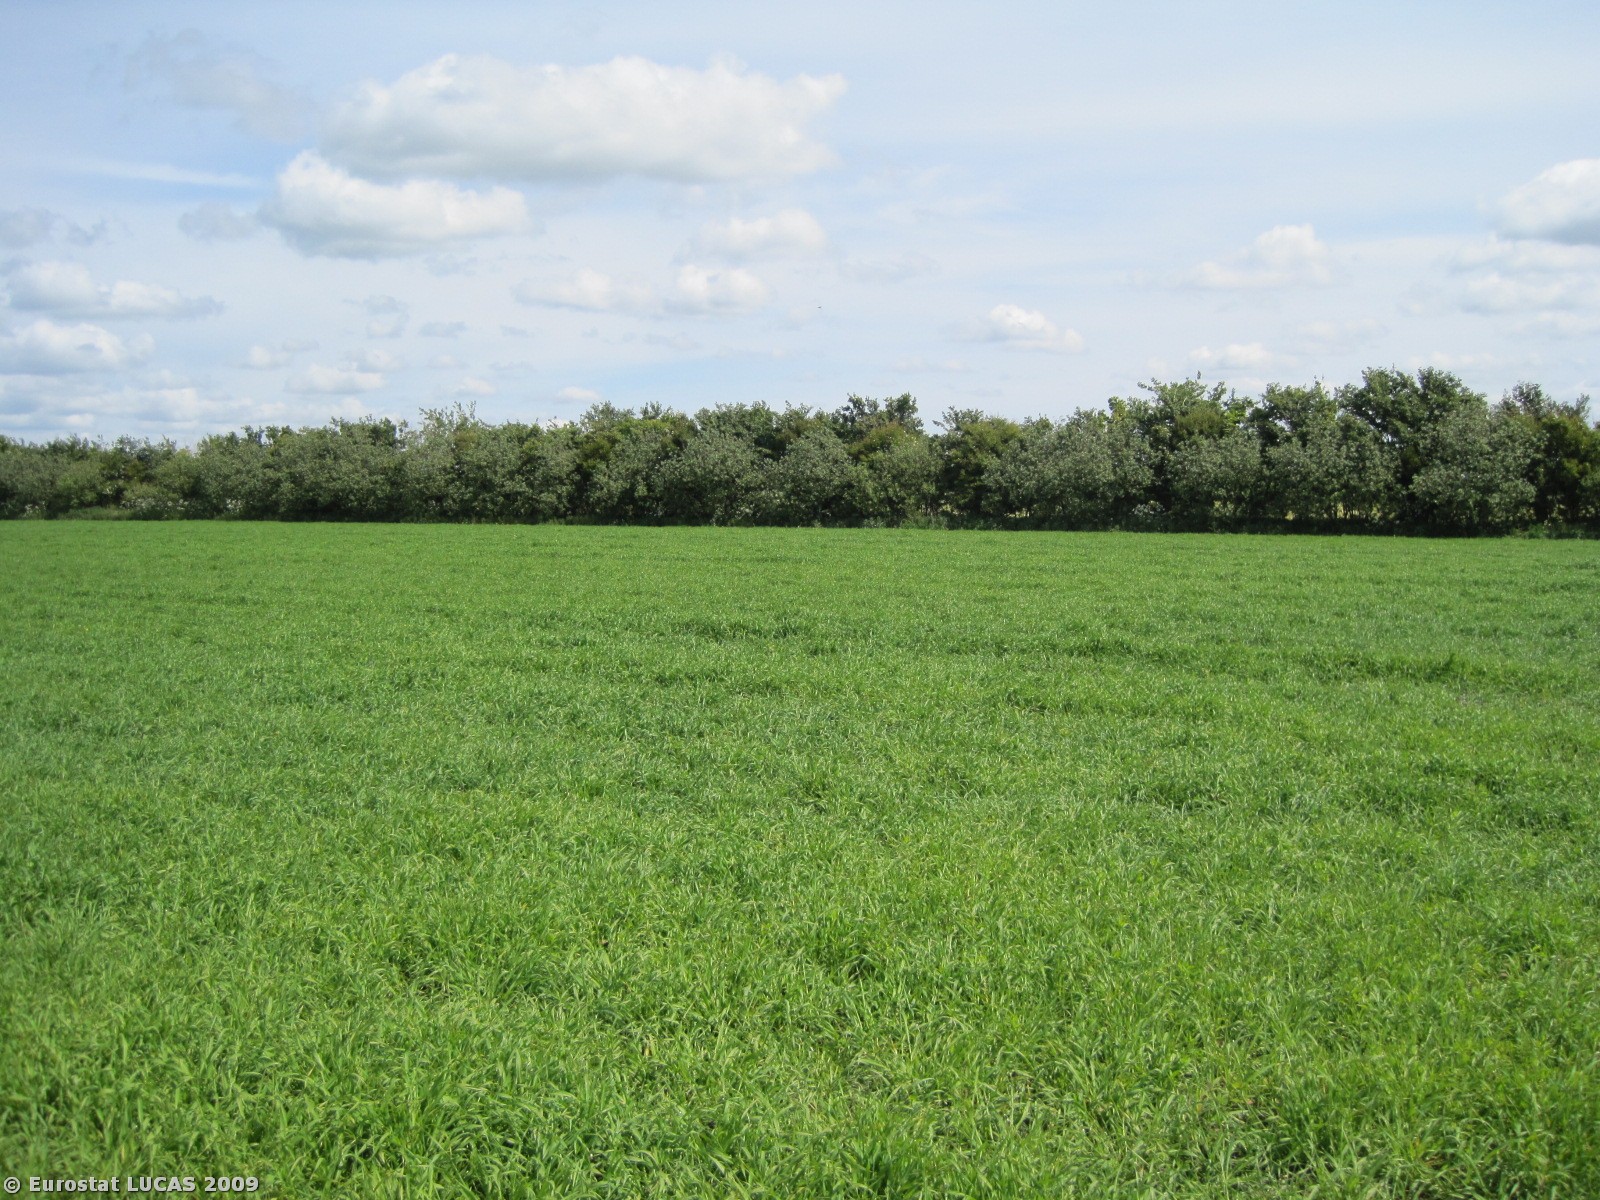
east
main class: Cropland
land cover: Barley
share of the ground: > 75 %
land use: Agriculture (excluding fallow land and kitchen gardens)
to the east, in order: Barley; Grass margins; Broadleaved woodland; Grass margins; Temporary grasslands
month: June
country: DK
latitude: 57.3561
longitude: 9.7843
